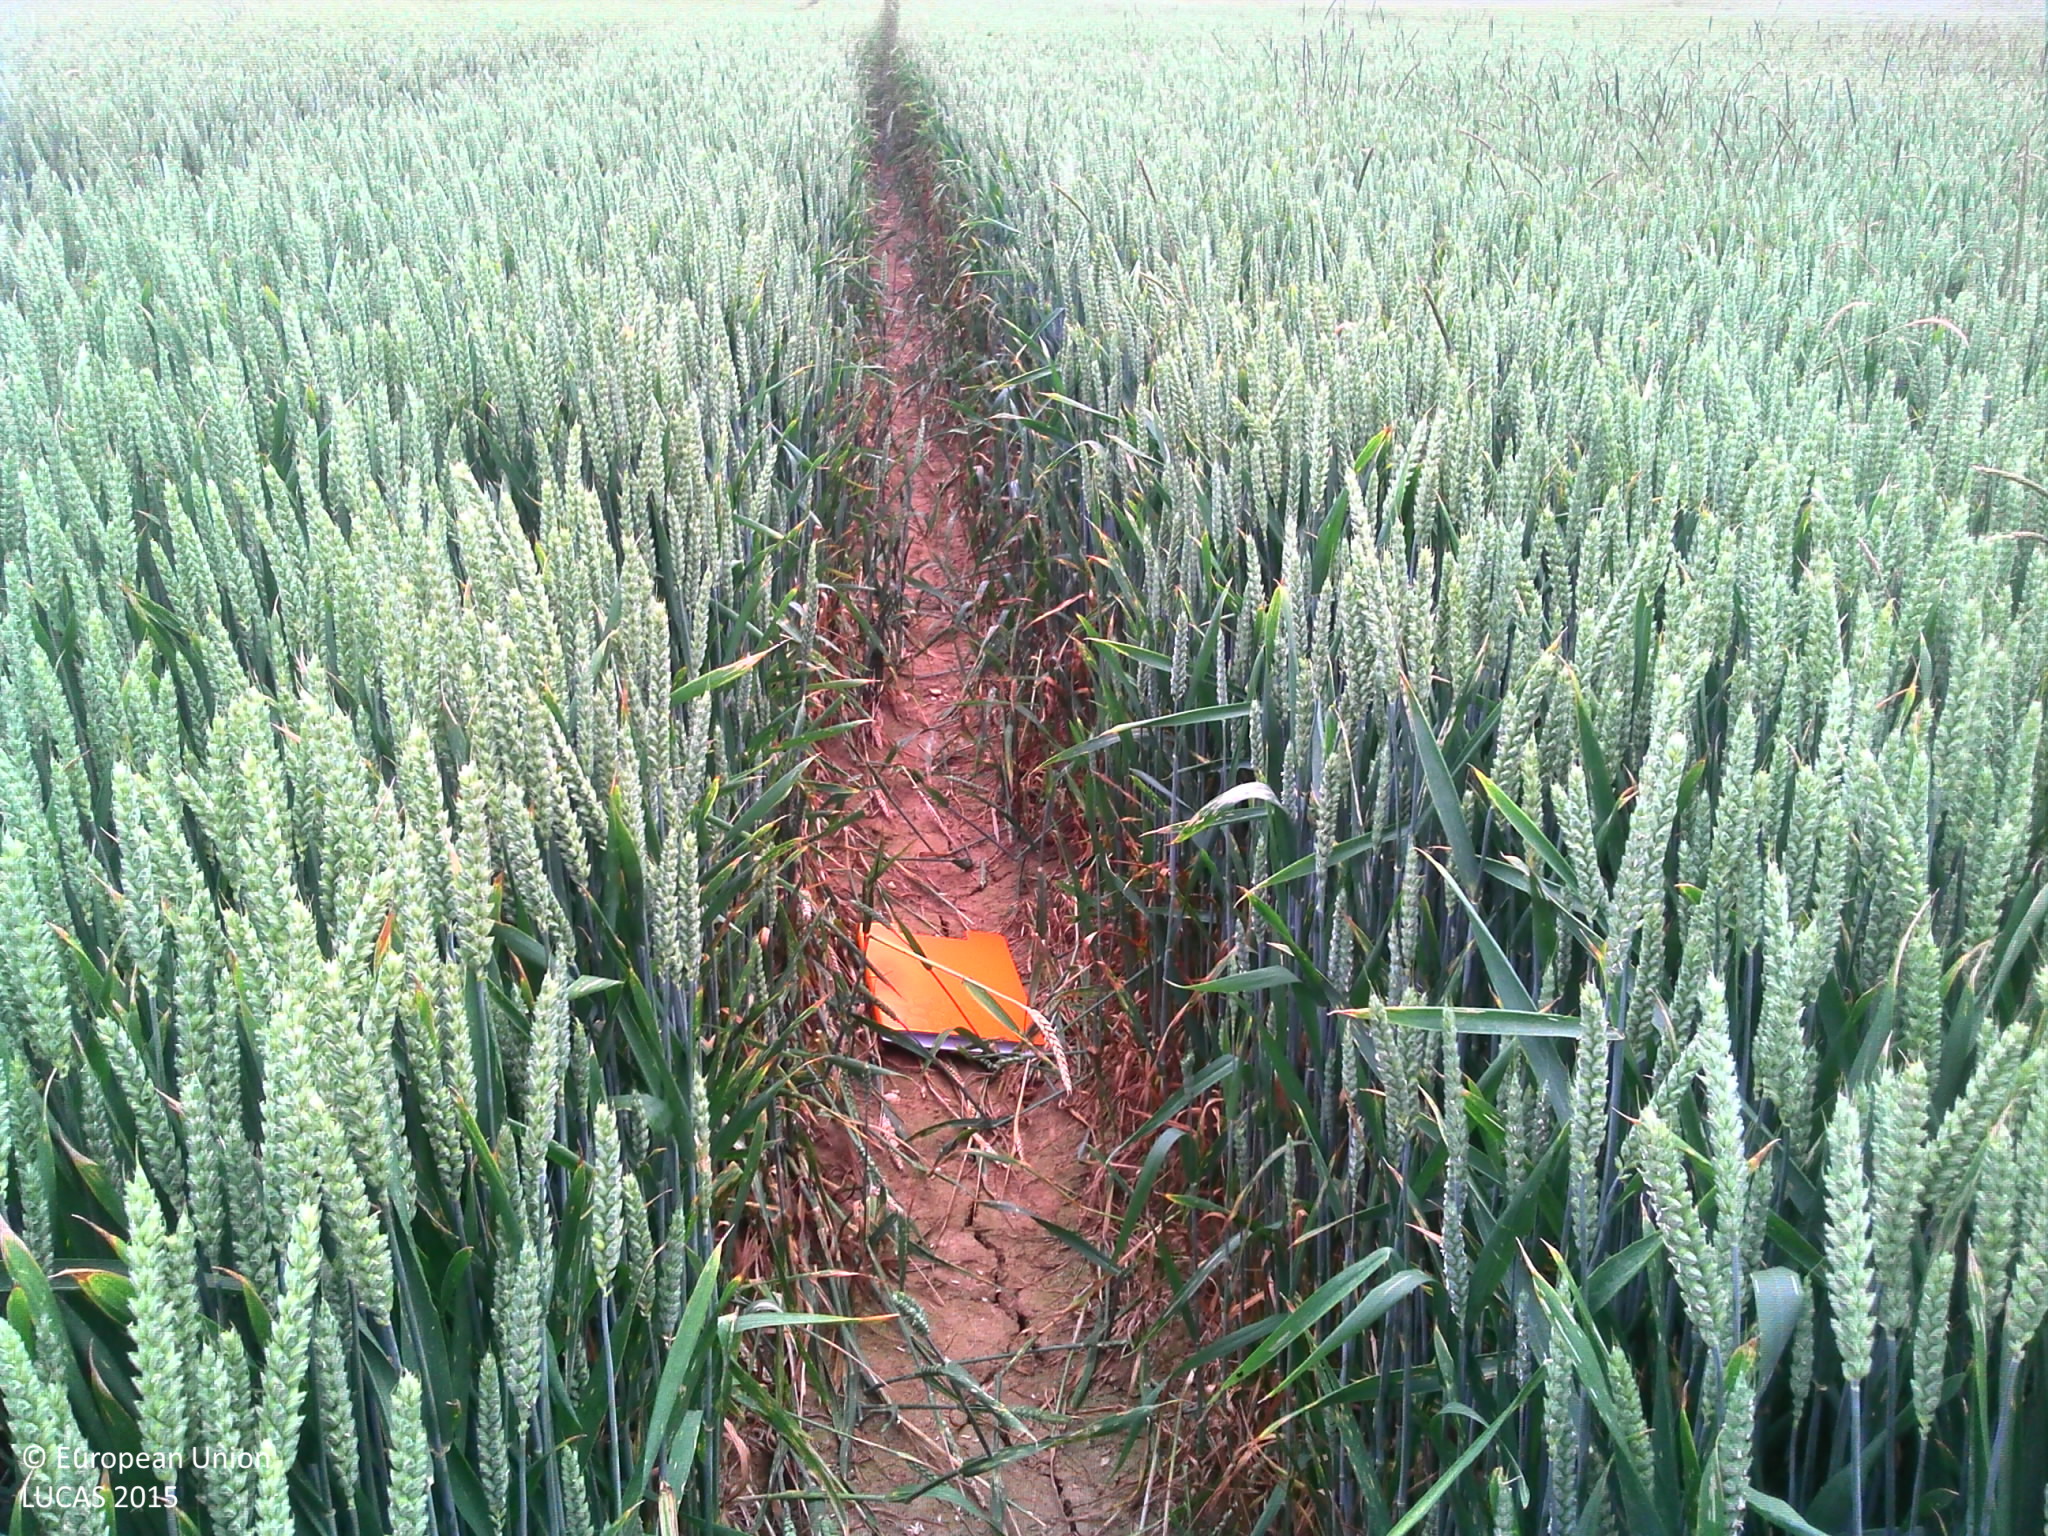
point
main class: Cropland
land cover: Common wheat
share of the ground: > 75 %
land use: Agriculture (excluding fallow land and kitchen gardens)
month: June
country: FR
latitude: 48.3572
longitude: 4.8834
